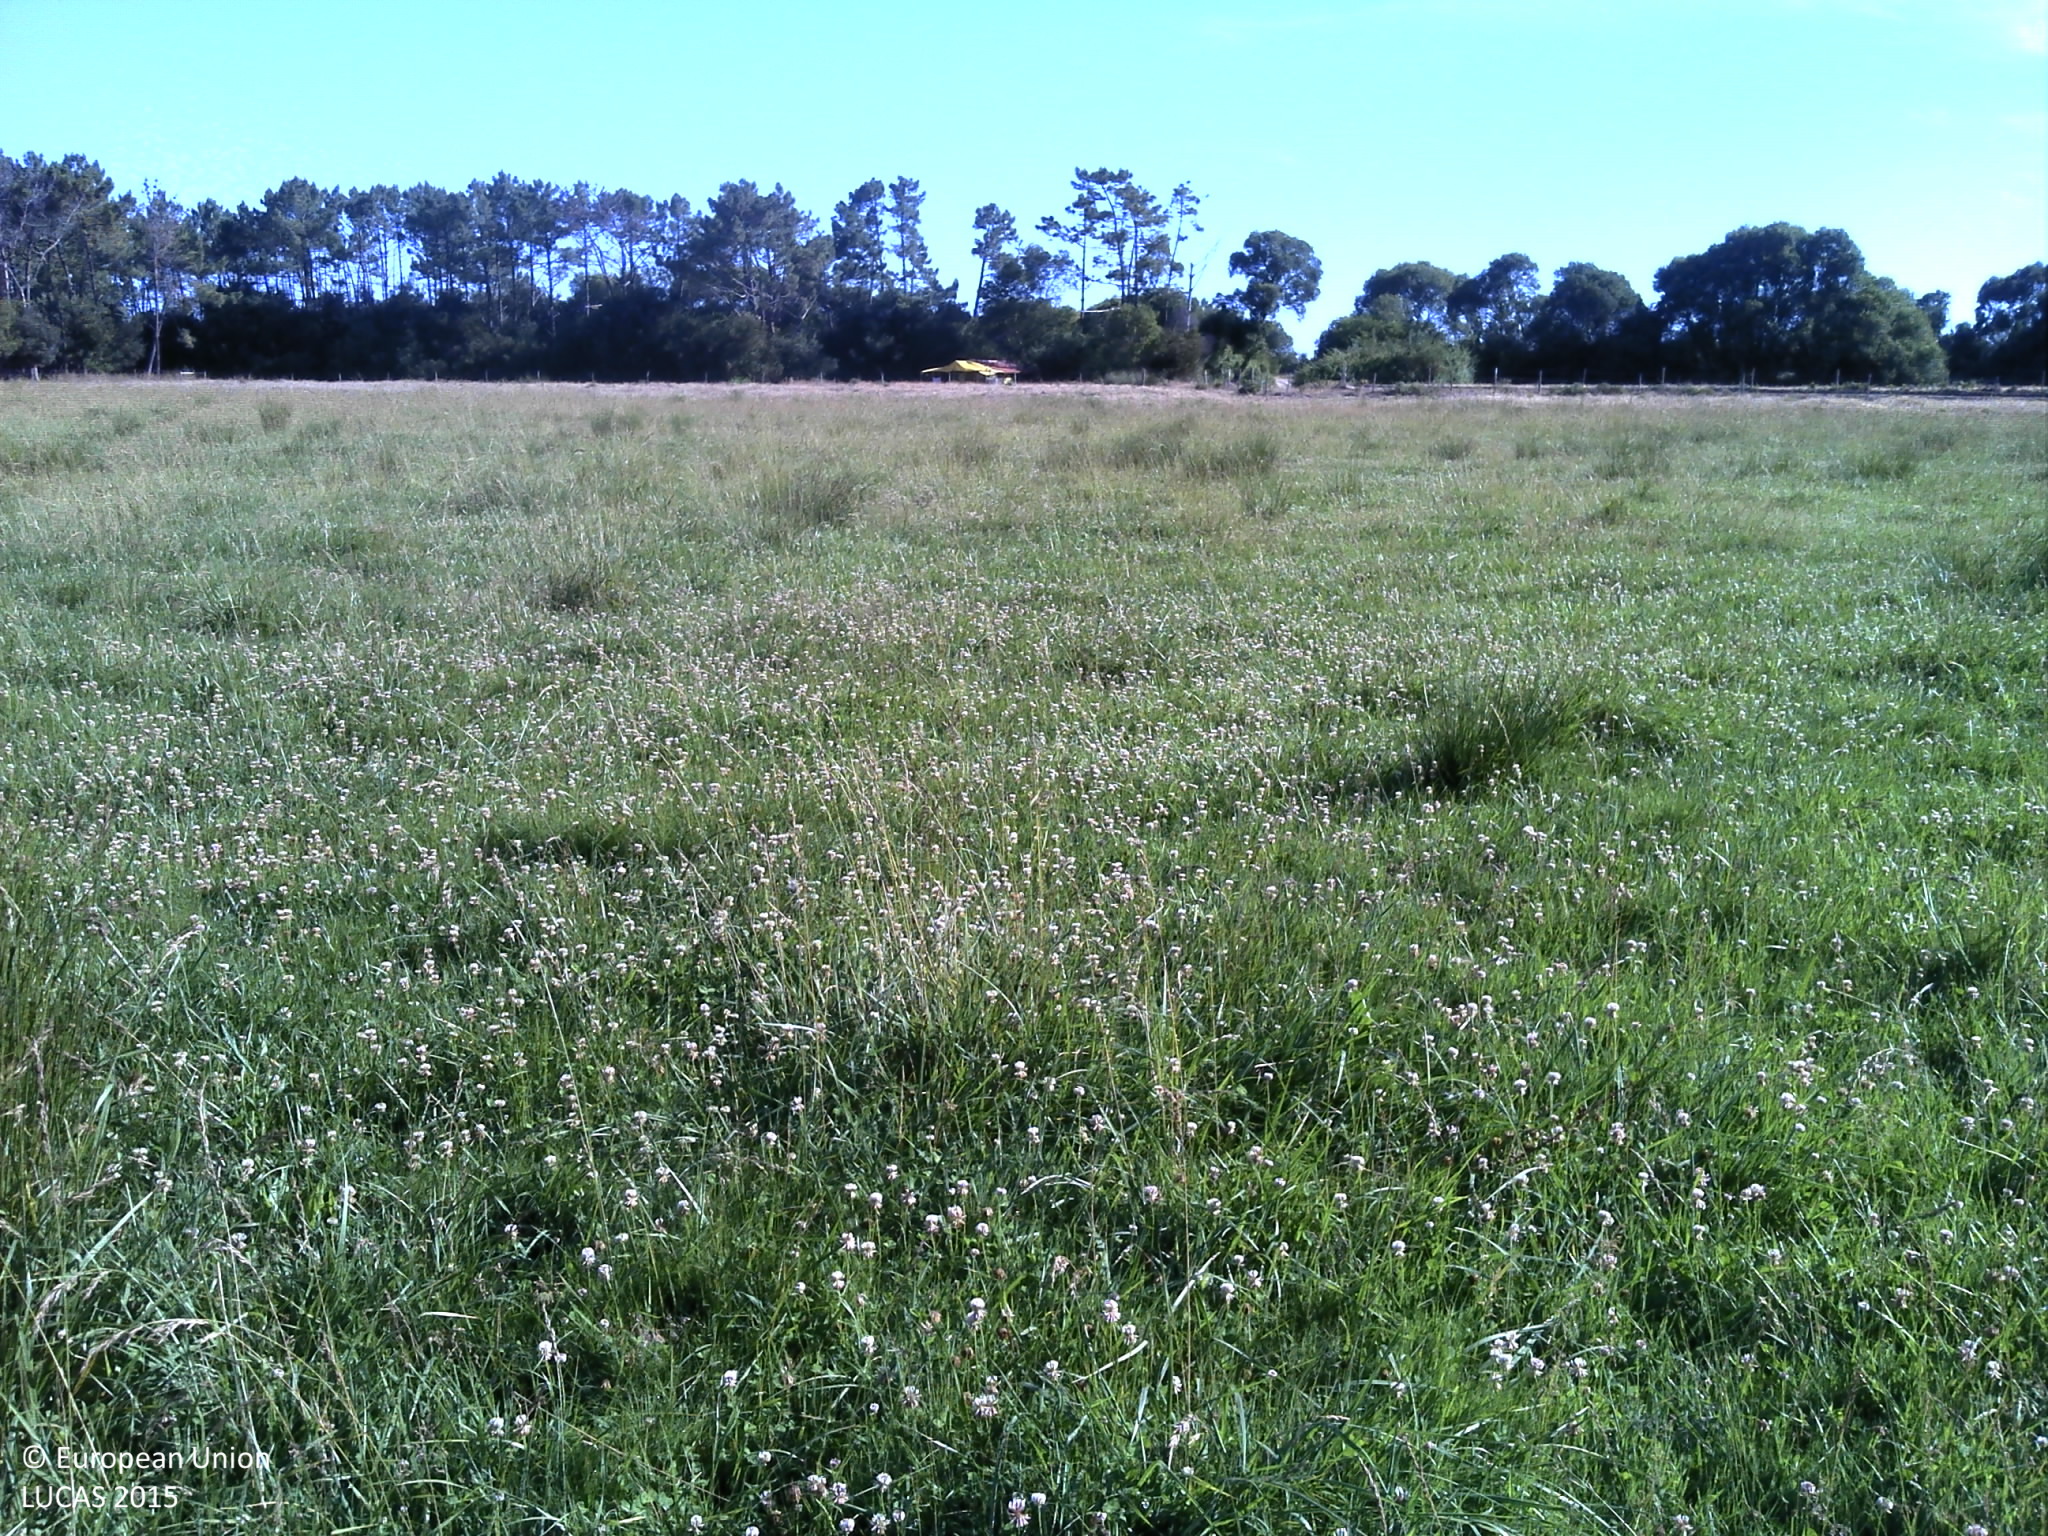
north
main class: Cropland
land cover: Temporary grasslands
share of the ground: > 75 %
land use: Agriculture (excluding fallow land and kitchen gardens)
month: June
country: PT
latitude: 37.4772
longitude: -8.7533
